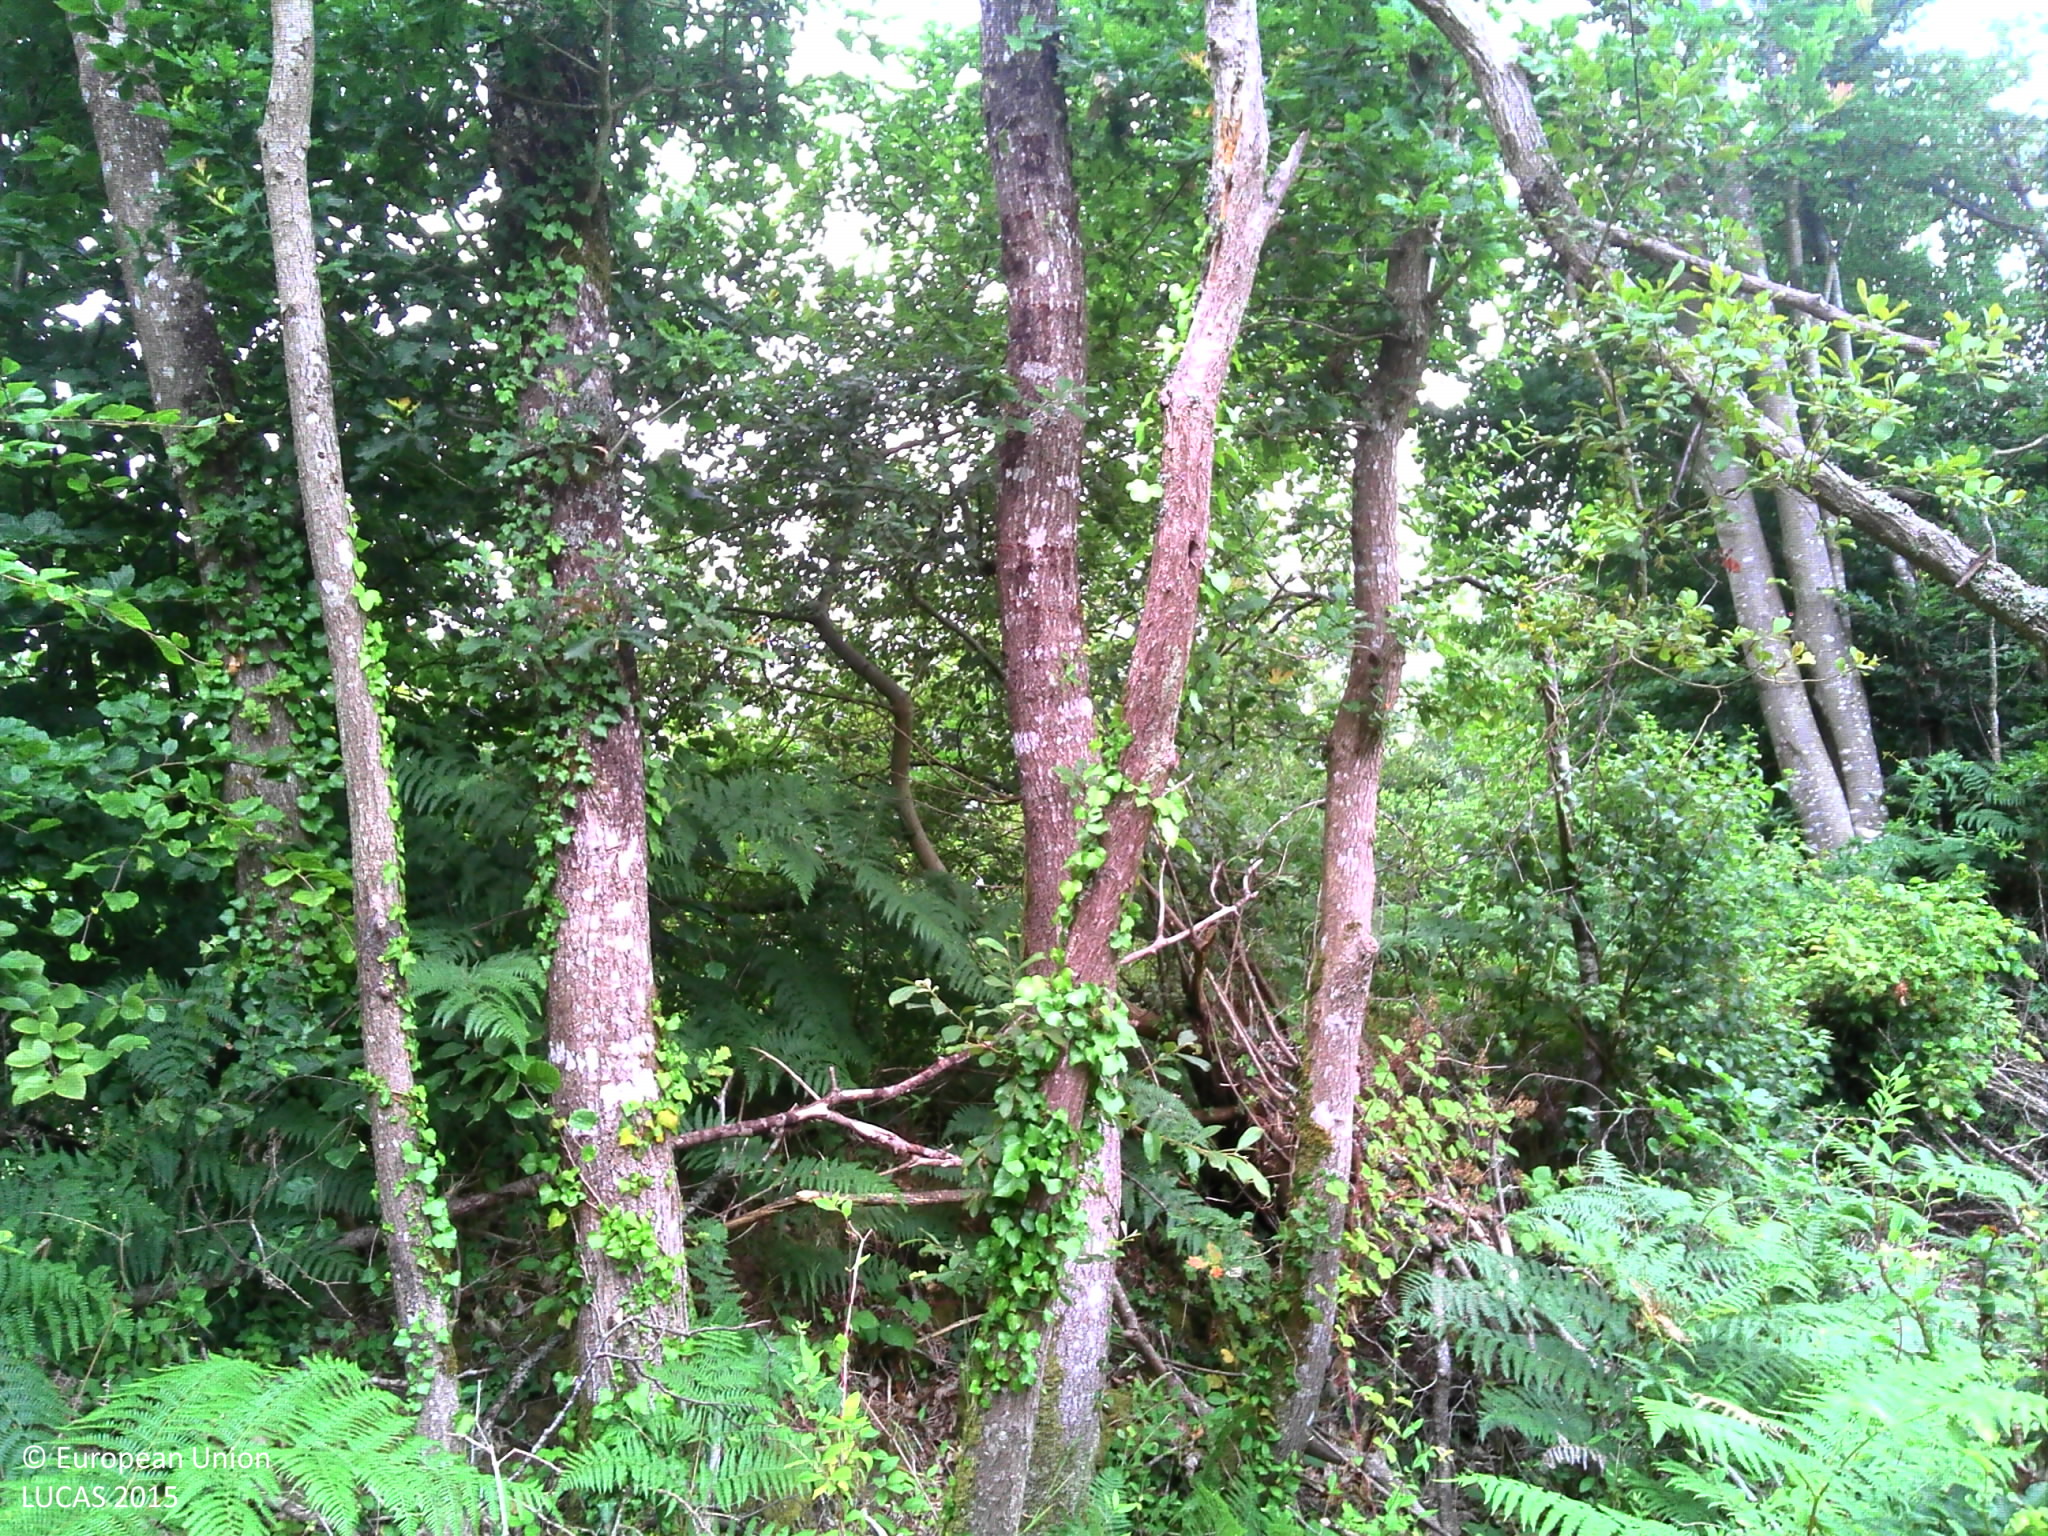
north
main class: Woodland
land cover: Broadleaved woodland
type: beech forest
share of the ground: > 75 %
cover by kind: herbaceous plants 65 %, broadleaved forest trees 20 %, unconsolidated bare surface 15 %
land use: Forestry
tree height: > 5 m
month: July
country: FR
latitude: 48.5859
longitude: -3.4037
